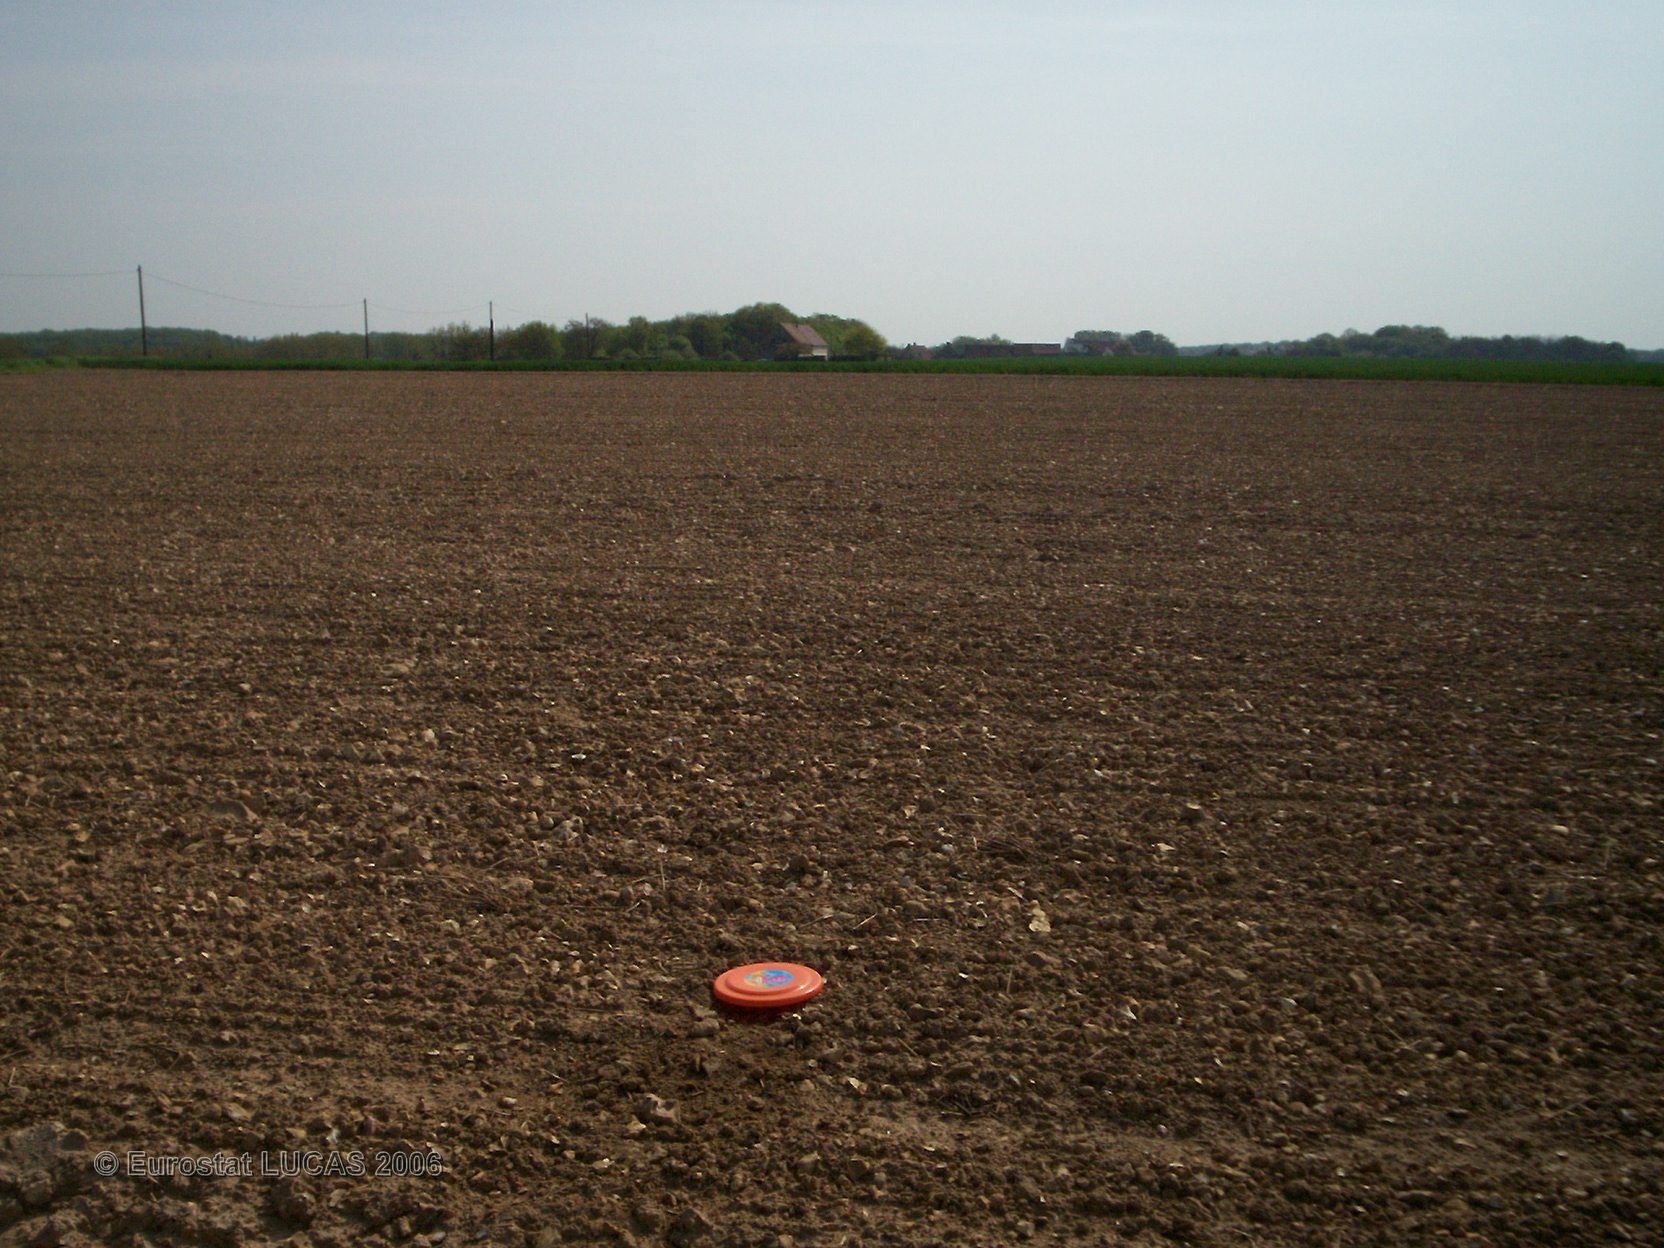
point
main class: Cropland
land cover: Sunflower
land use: Agriculture (excluding fallow land and kitchen gardens)
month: May
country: FR
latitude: 48.0502
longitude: 2.9225
